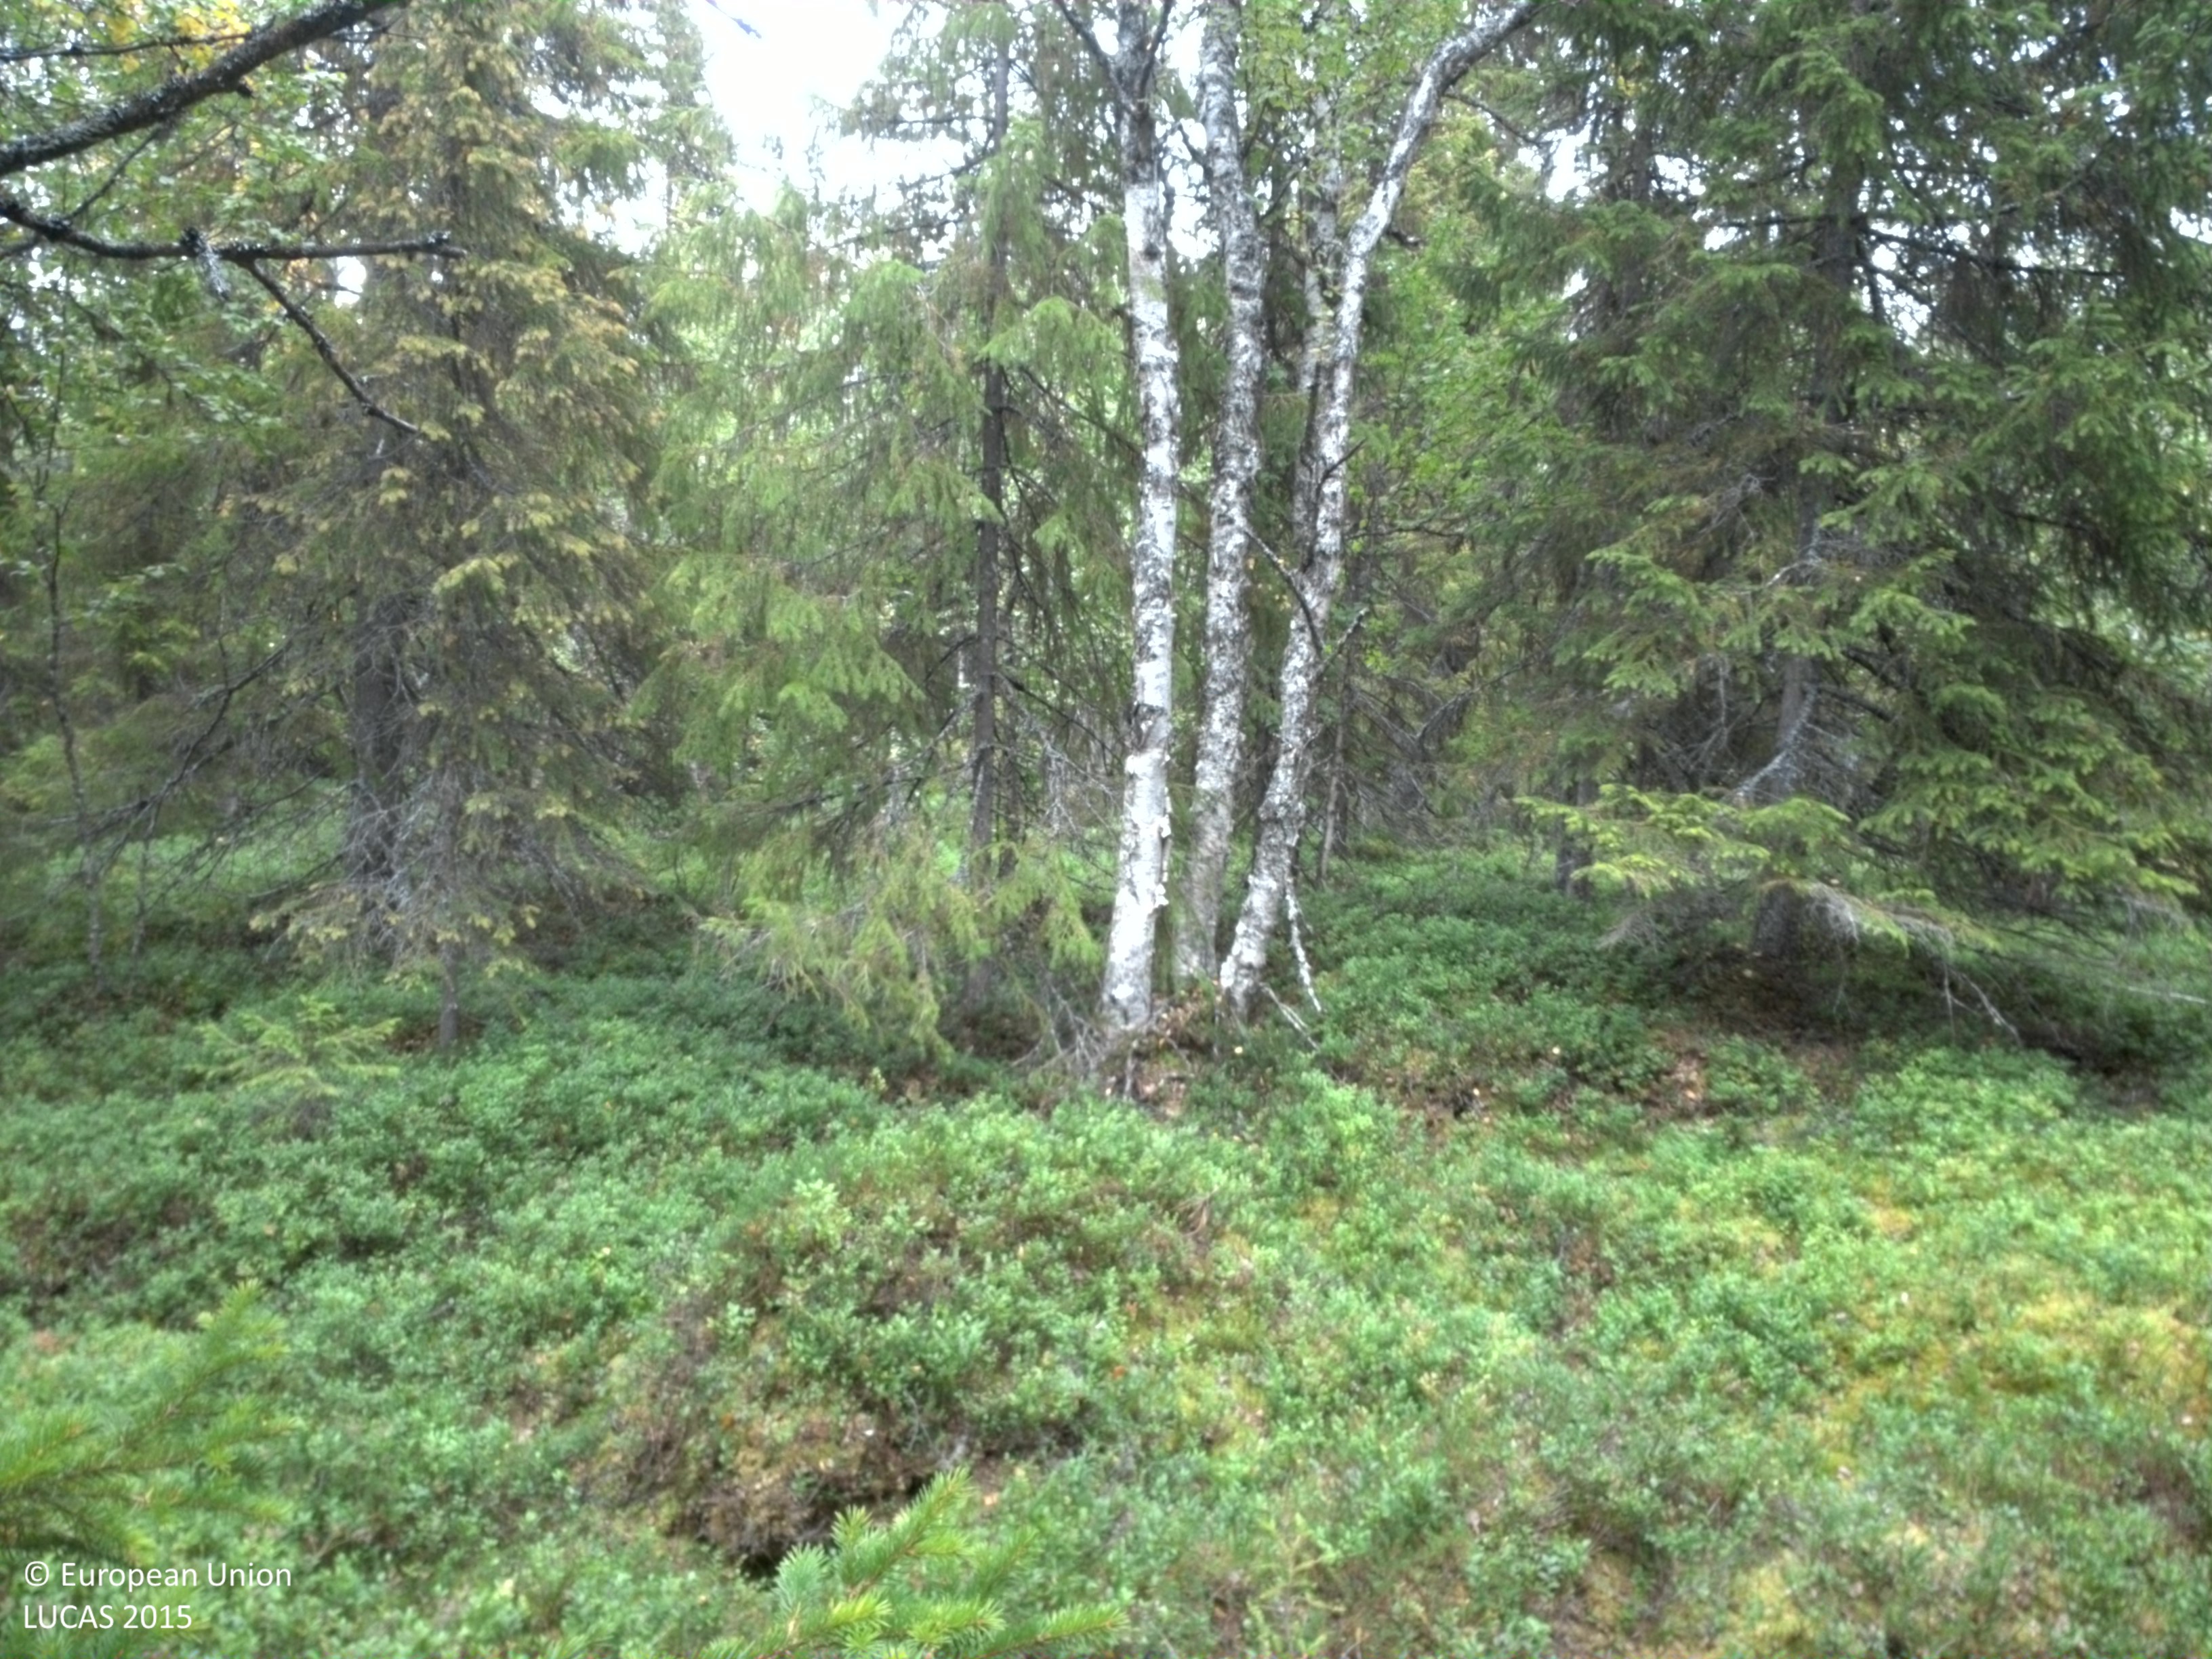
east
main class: Woodland
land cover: Spruce dominated mixed woodland
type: boreal forest
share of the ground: 50 - 75 %
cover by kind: shrubs 30 %, coniferous forest trees 25 %, broadleaved forest trees 25 %, lichens and mosses 20 %
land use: Forestry
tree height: > 5 m
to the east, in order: Spruce dominated mixed woodland; Shrubland without tree cover; Spruce dominated mixed woodland; Broadleaved woodland; Ditches and canals; Groves; Paved roads, cycling and walking lanes; Broadleaved woodland; Spruce dominated coniferous woodland; Spruce dominated mixed woodland; Peatbogs
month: September
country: SE
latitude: 65.3671
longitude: 16.1344
